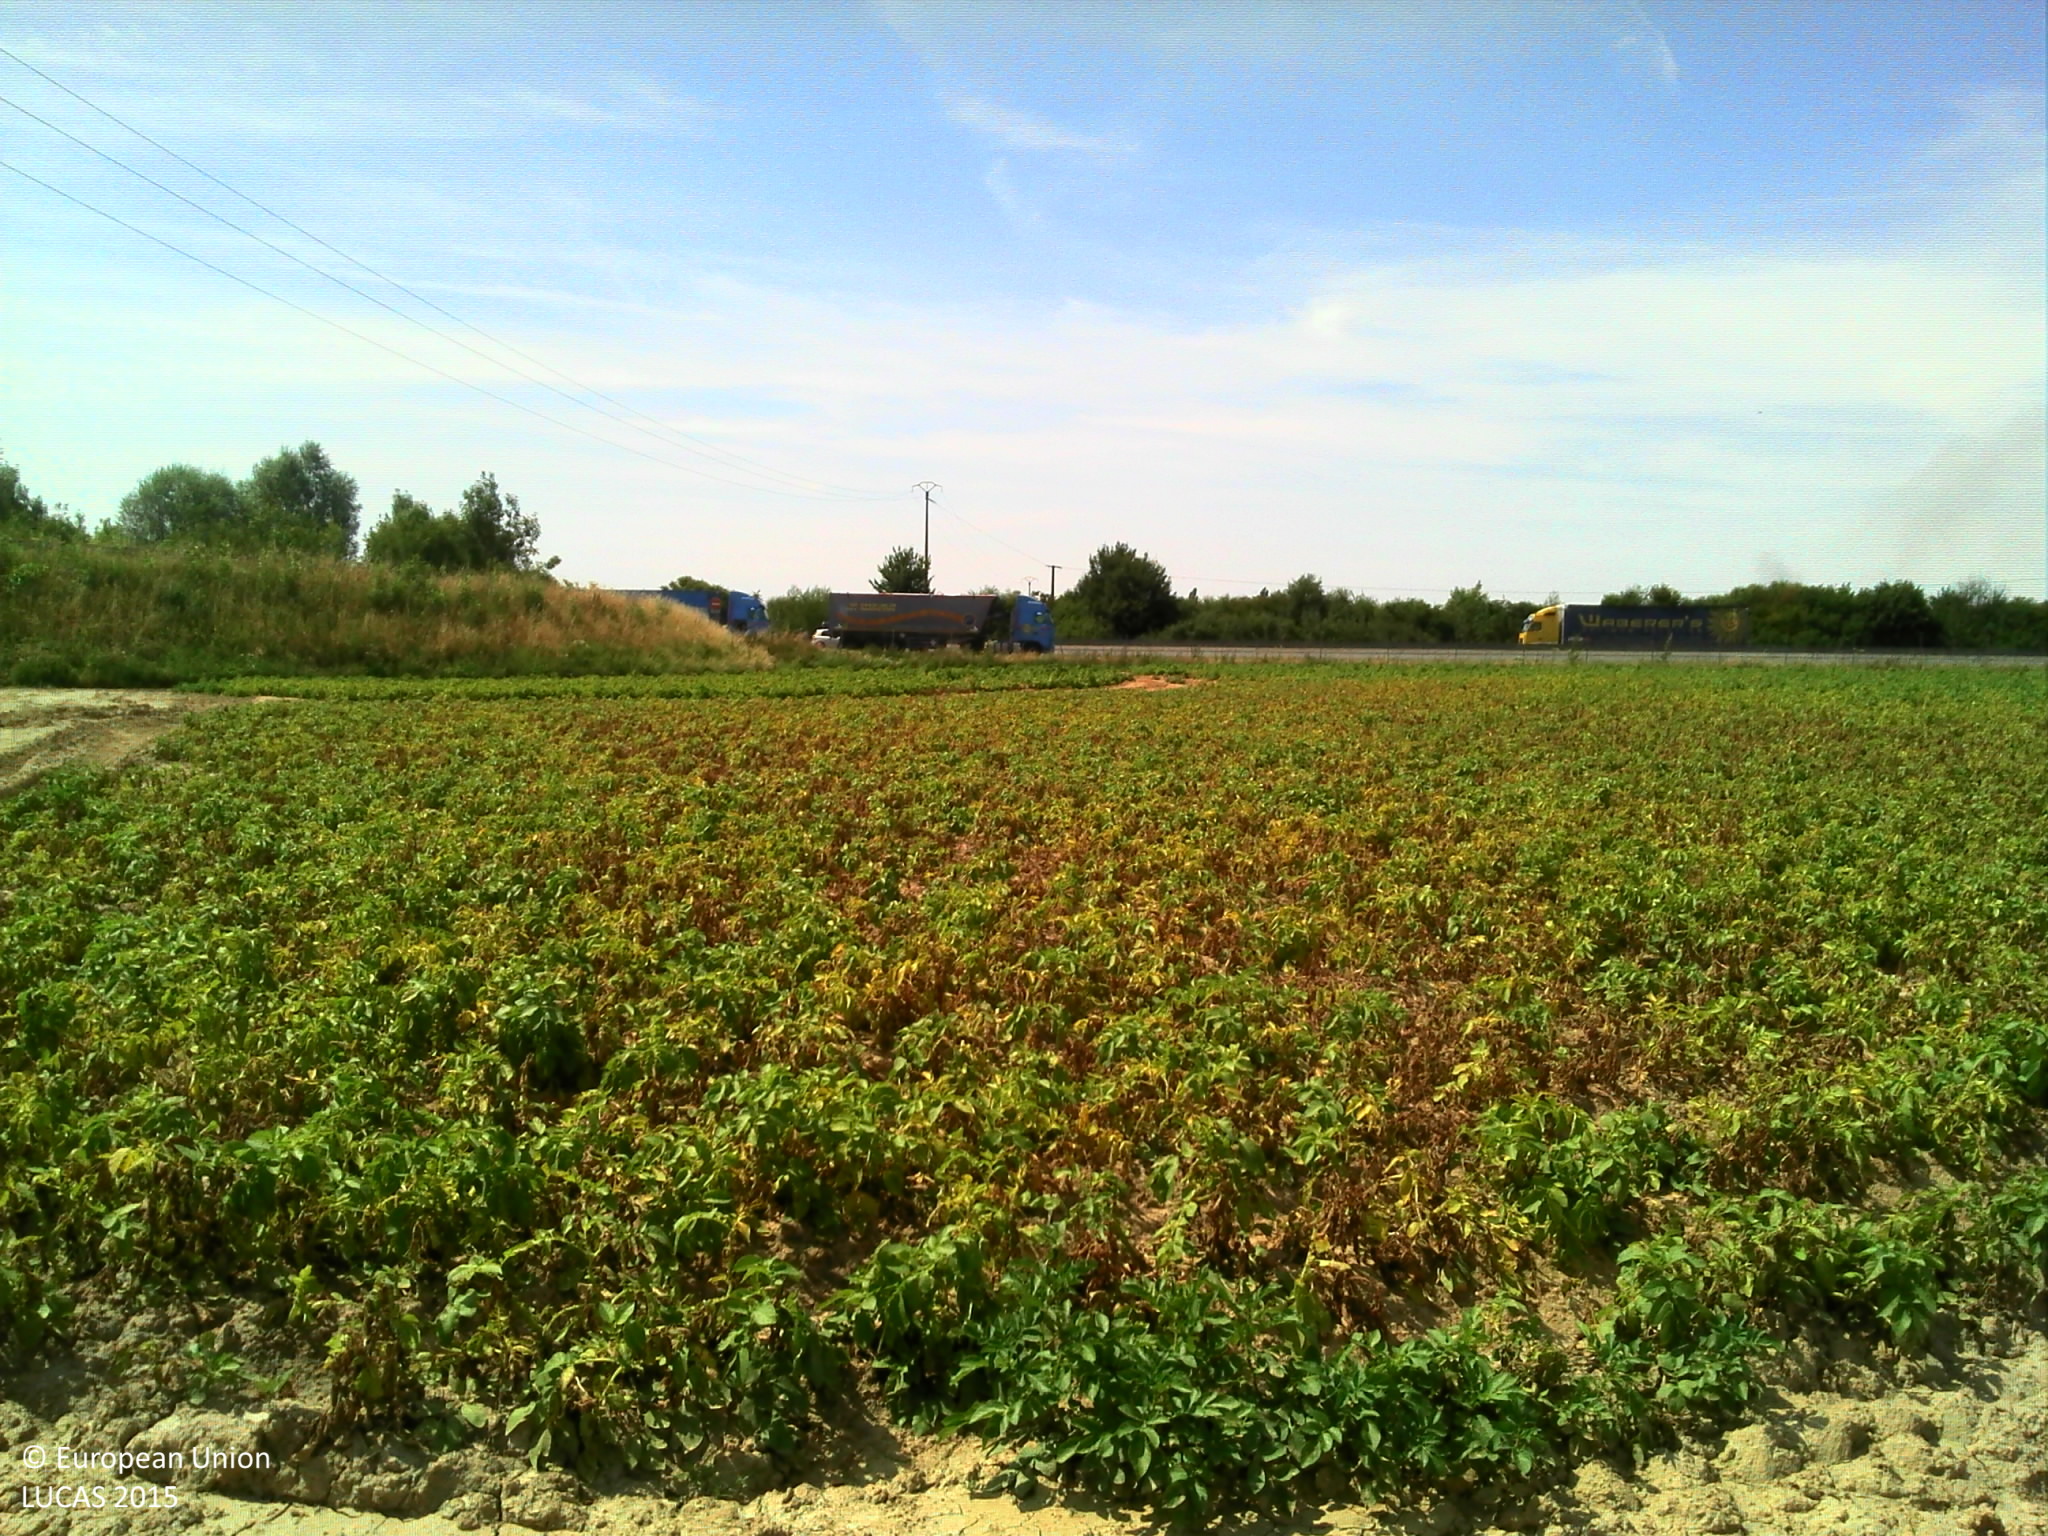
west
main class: Cropland
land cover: Potatoes
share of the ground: 25 - 50 %
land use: Agriculture (excluding fallow land and kitchen gardens)
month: August
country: FR
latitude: 49.7390
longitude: 2.7877
